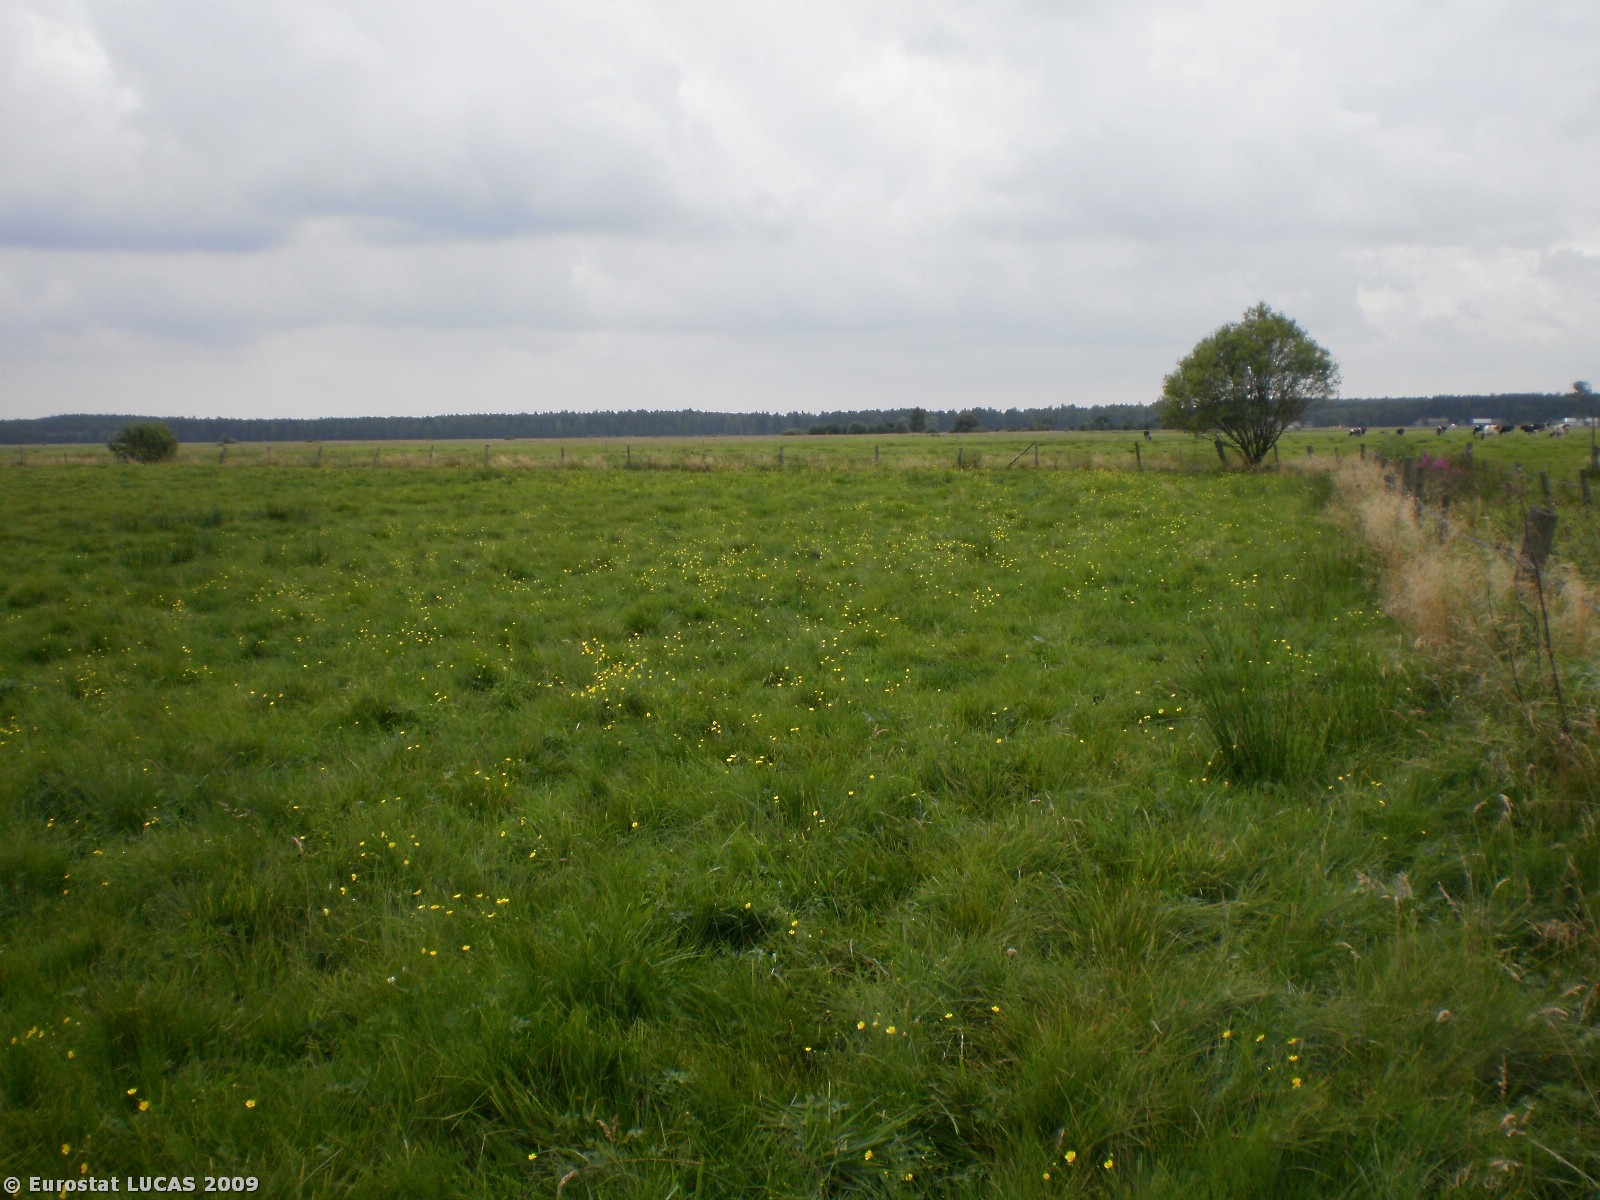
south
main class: Grassland
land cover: Grassland without tree/shrub cover
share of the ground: > 75 %
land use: Agriculture (excluding fallow land and kitchen gardens)
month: August
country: PL
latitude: 53.2904
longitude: 21.2834
